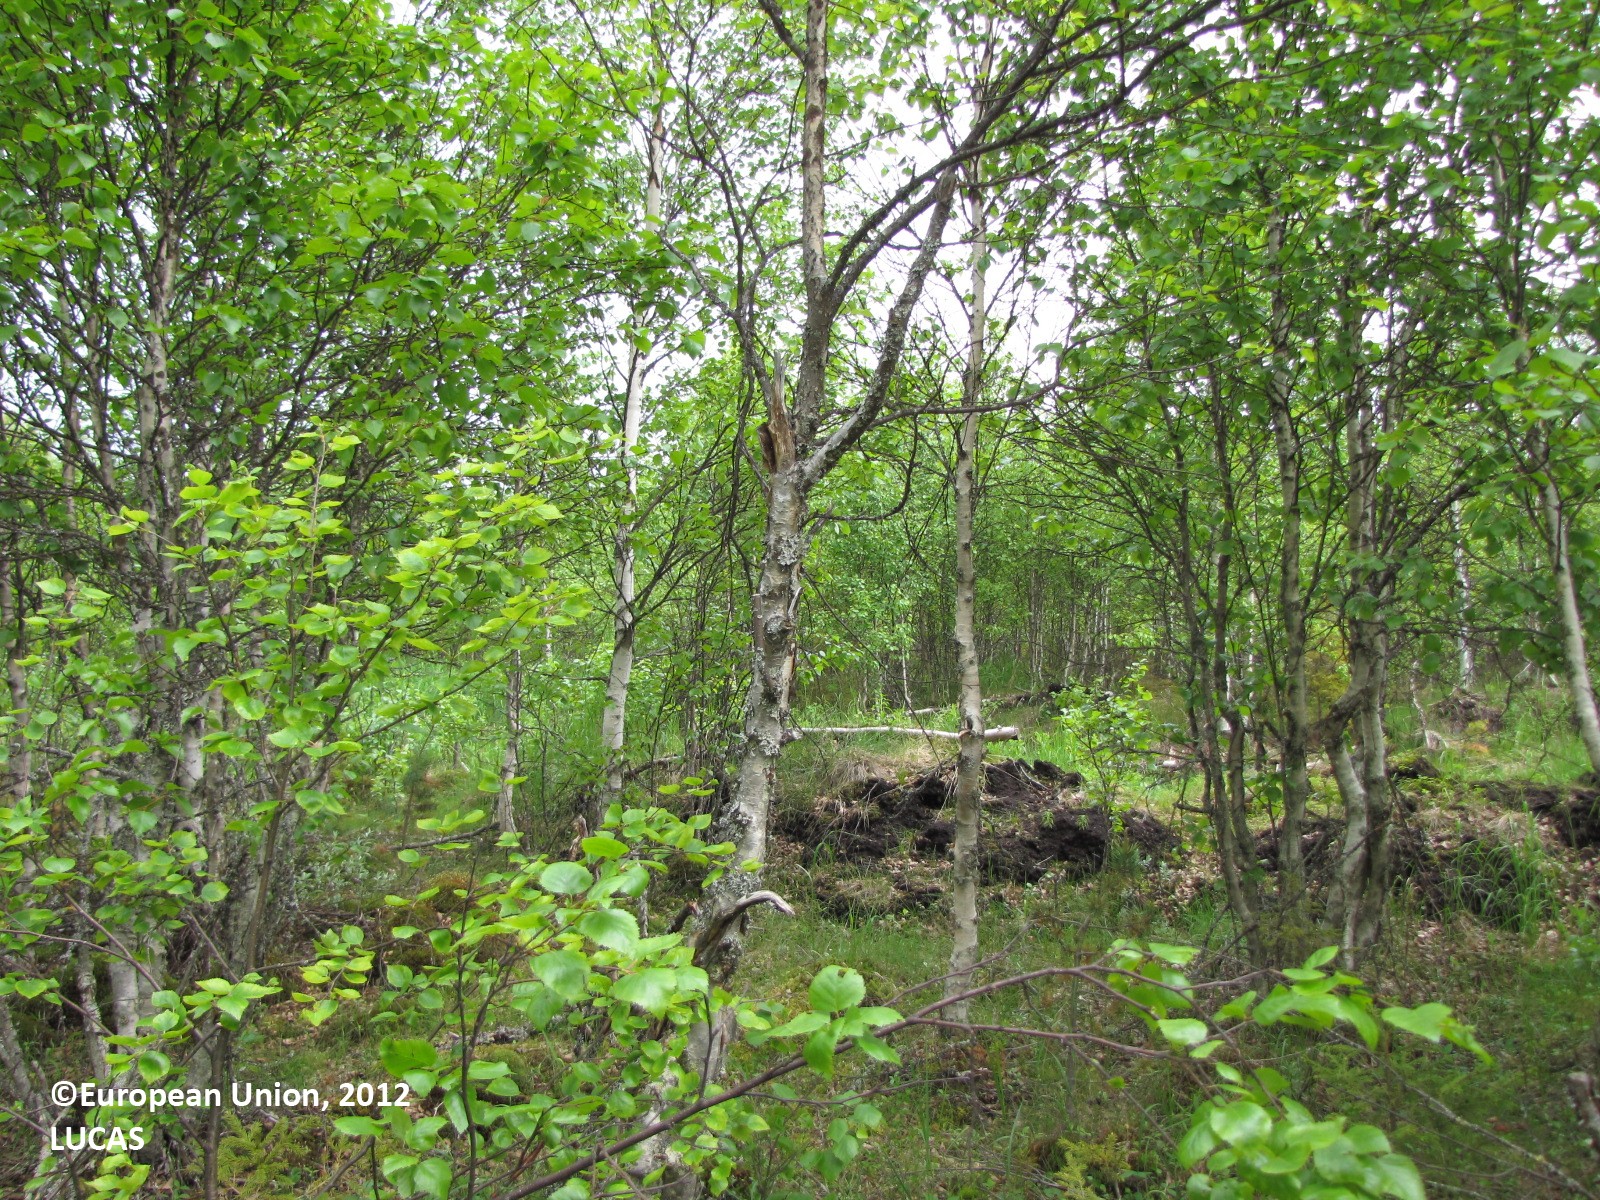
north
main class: Woodland
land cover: Broadleaved woodland
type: boreal forest
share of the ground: > 75 %
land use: Forestry
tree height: > 5 m
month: June
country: FI
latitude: 66.1492
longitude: 24.6573
